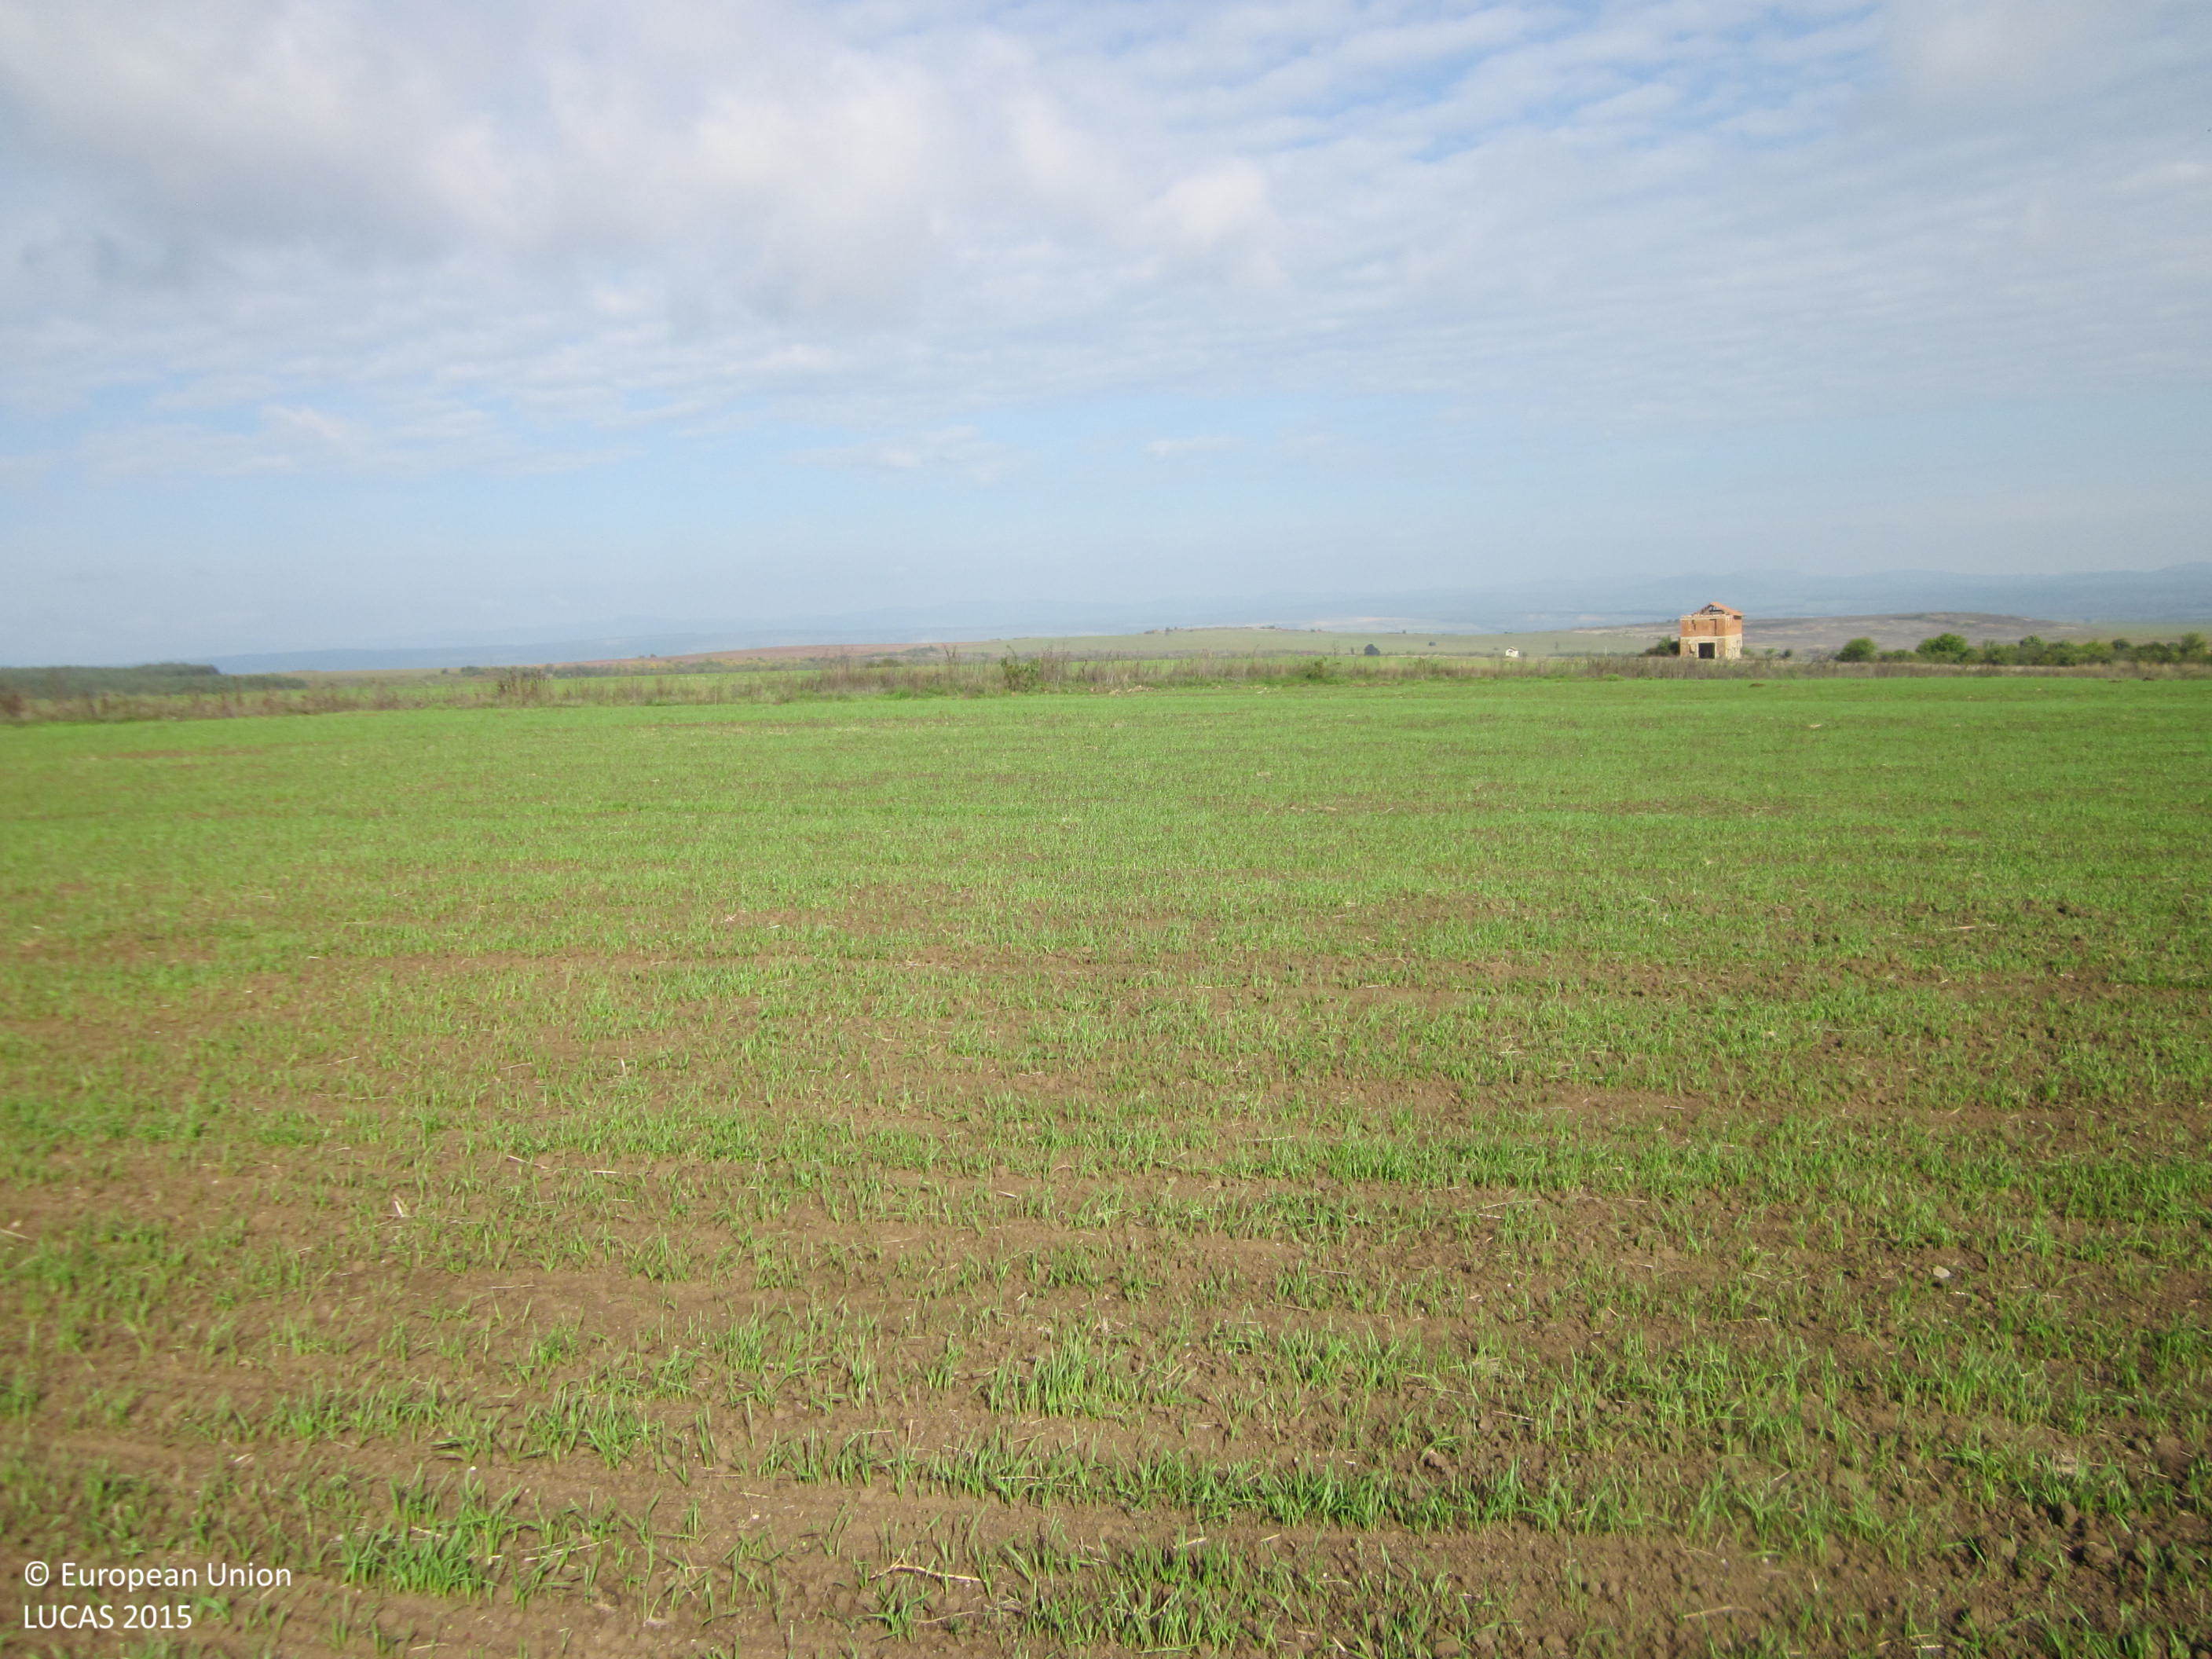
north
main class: Cropland
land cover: Common wheat
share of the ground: 25 - 50 %
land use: Agriculture (excluding fallow land and kitchen gardens)
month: October
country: BG
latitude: 42.6909
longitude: 26.8120
